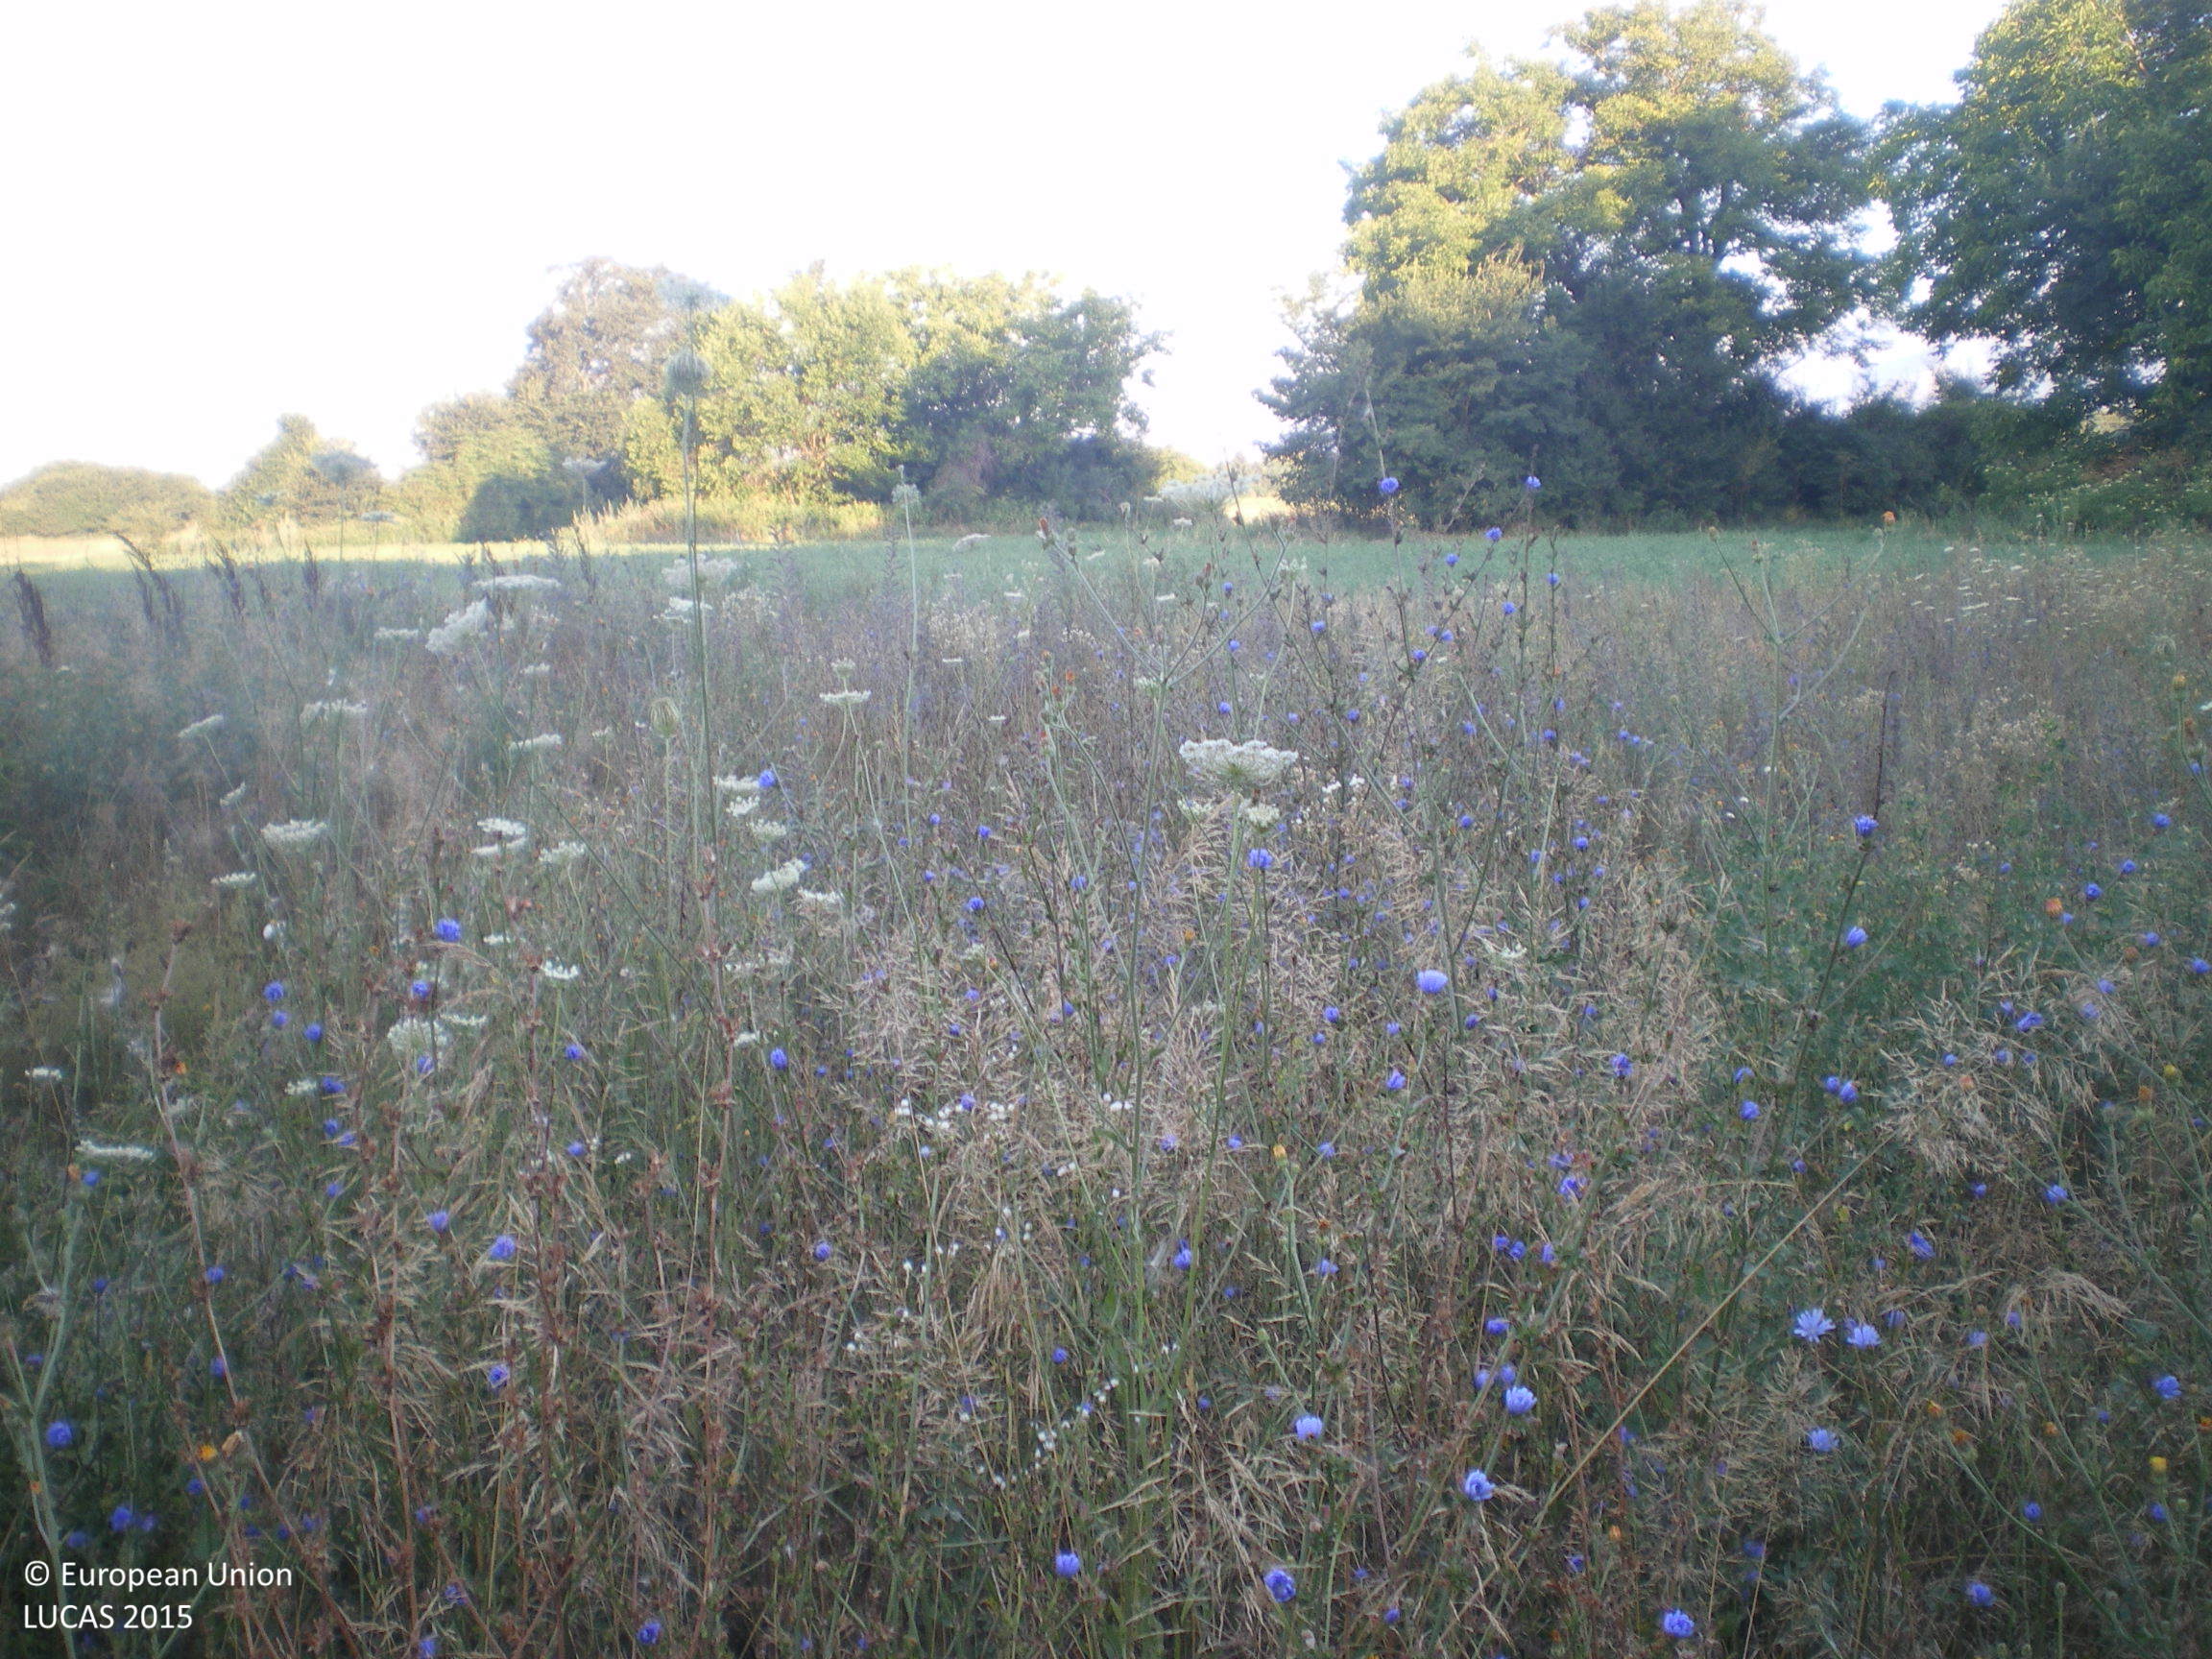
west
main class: Grassland
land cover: Spontaneously vegetated surfaces
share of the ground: > 75 %
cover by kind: herbaceous plants 100 %
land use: Agriculture (excluding fallow land and kitchen gardens)
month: July
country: BG
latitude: 42.6291
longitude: 25.2476
